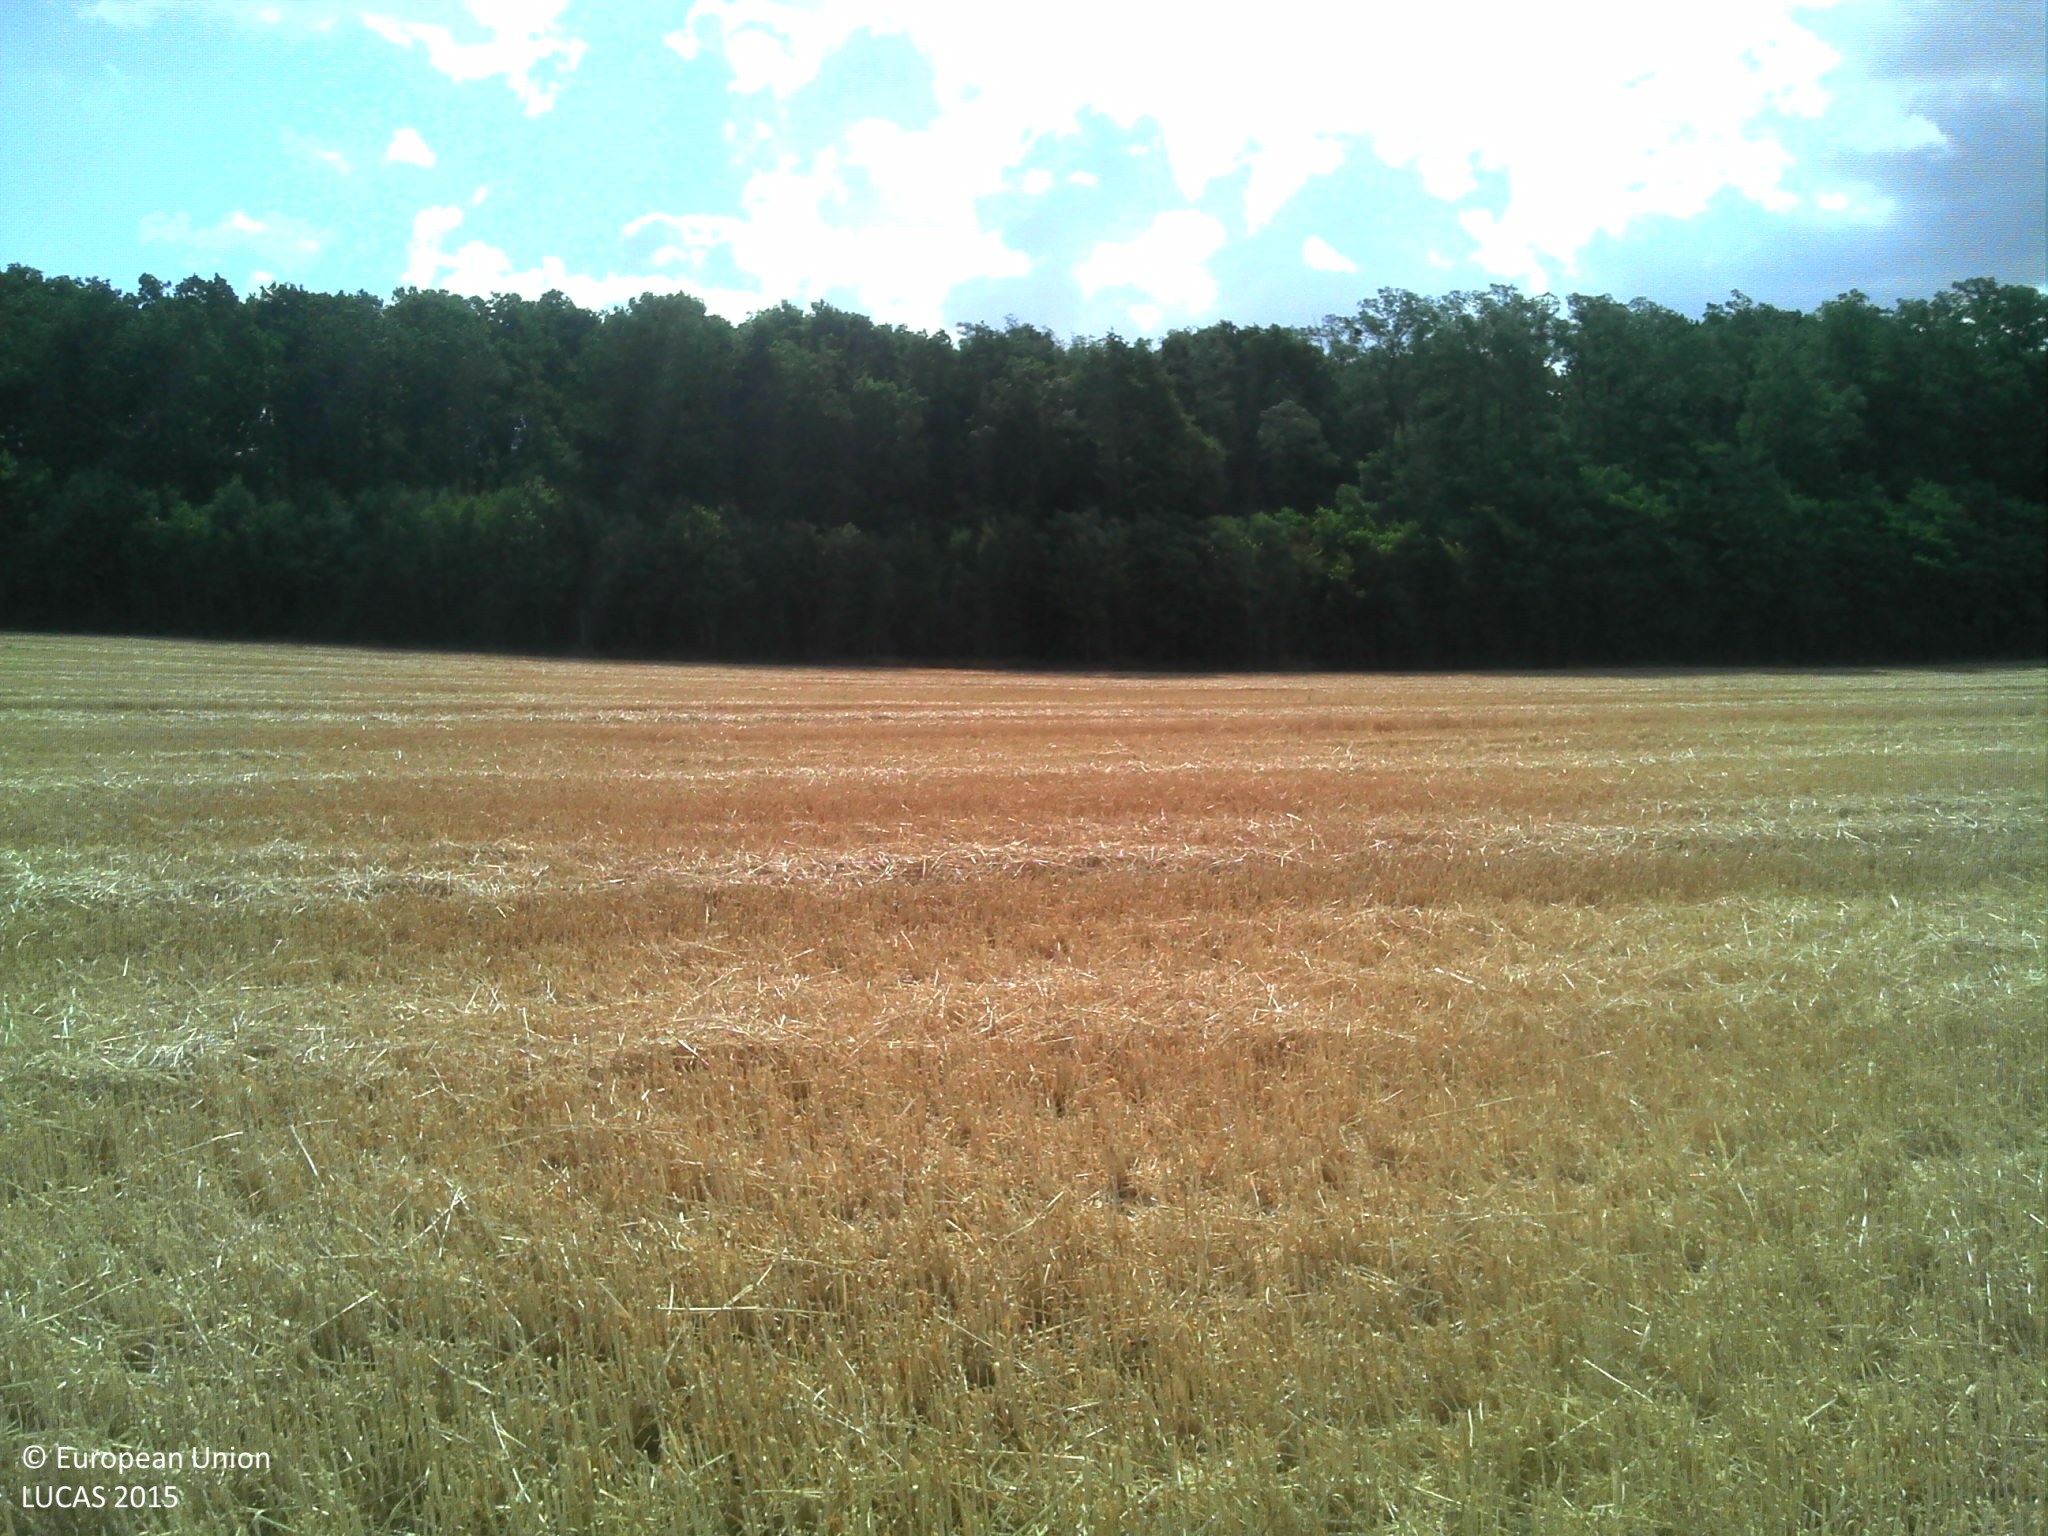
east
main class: Cropland
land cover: Common wheat
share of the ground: > 75 %
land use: Agriculture (excluding fallow land and kitchen gardens)
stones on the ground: 10 - 25 %
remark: Harvested field
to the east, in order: Common wheat; Grass margins; Broadleaved woodland
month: July
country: FR
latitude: 48.2608
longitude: 3.4070
